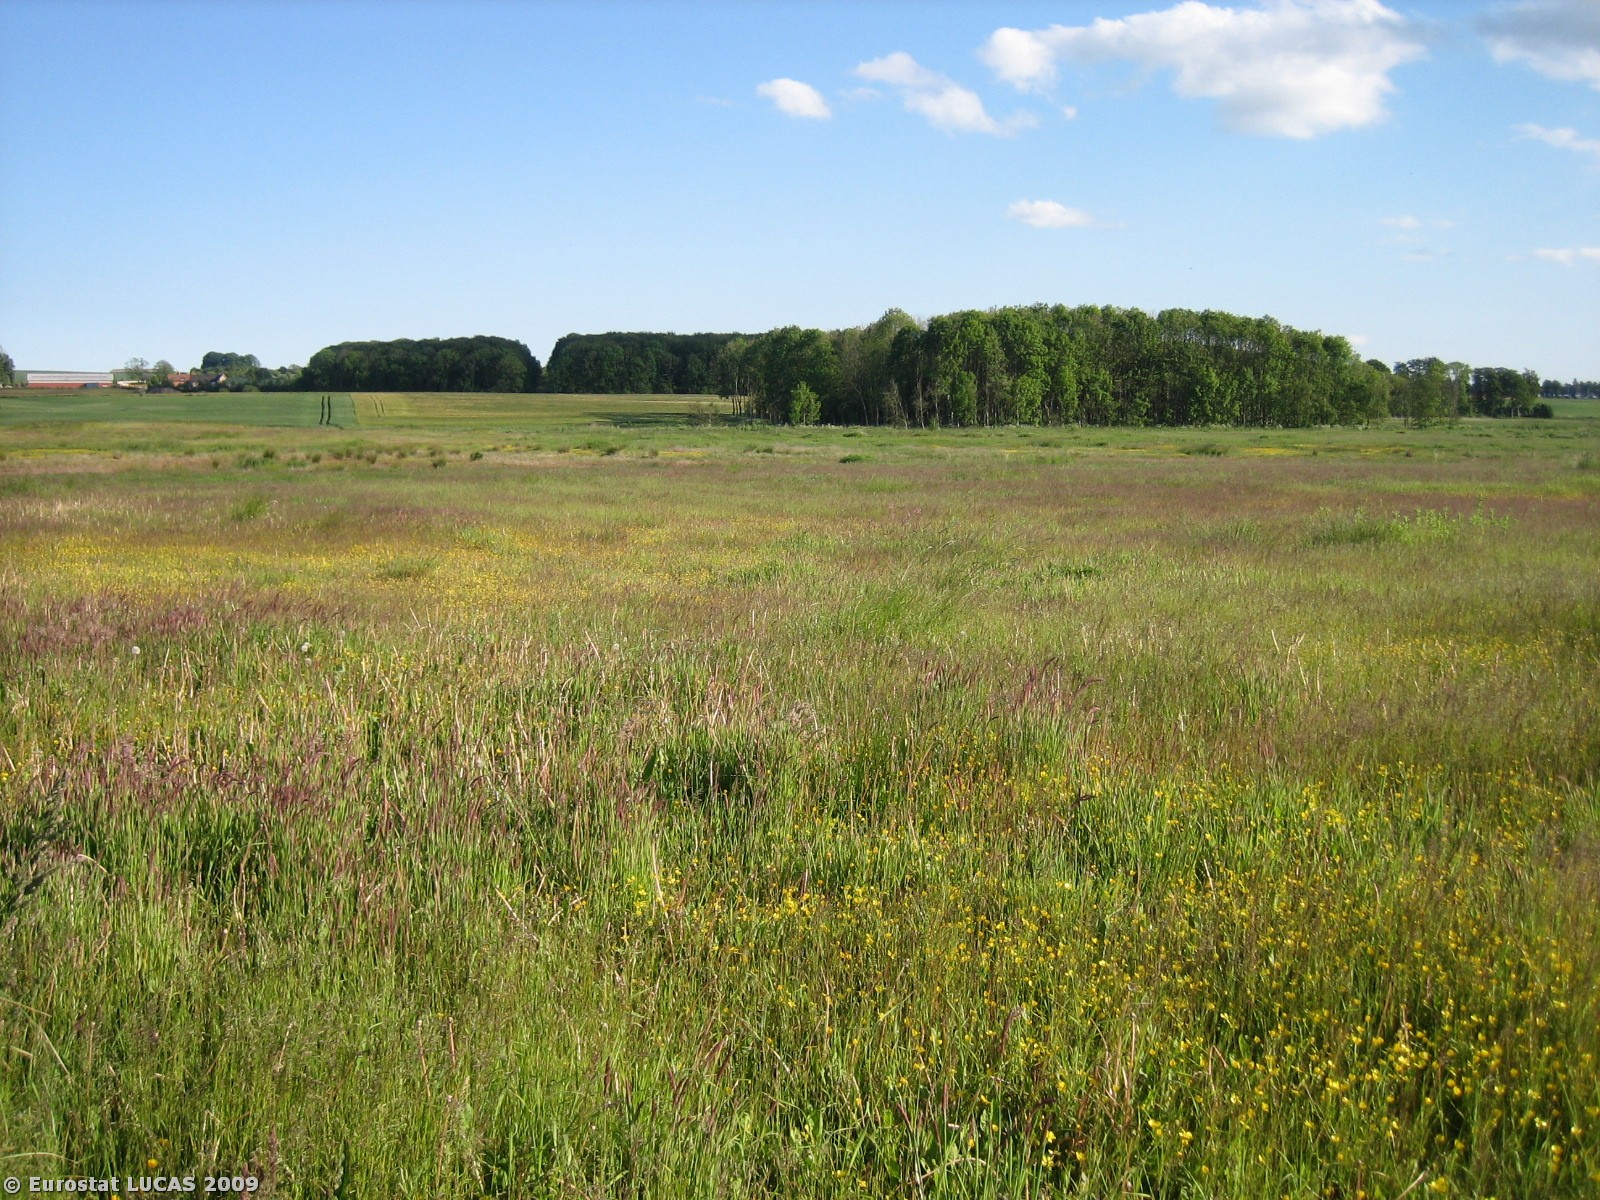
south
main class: Grassland
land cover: Grassland without tree/shrub cover
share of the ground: > 75 %
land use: Unused
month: June
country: DK
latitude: 56.1697
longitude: 9.9196
